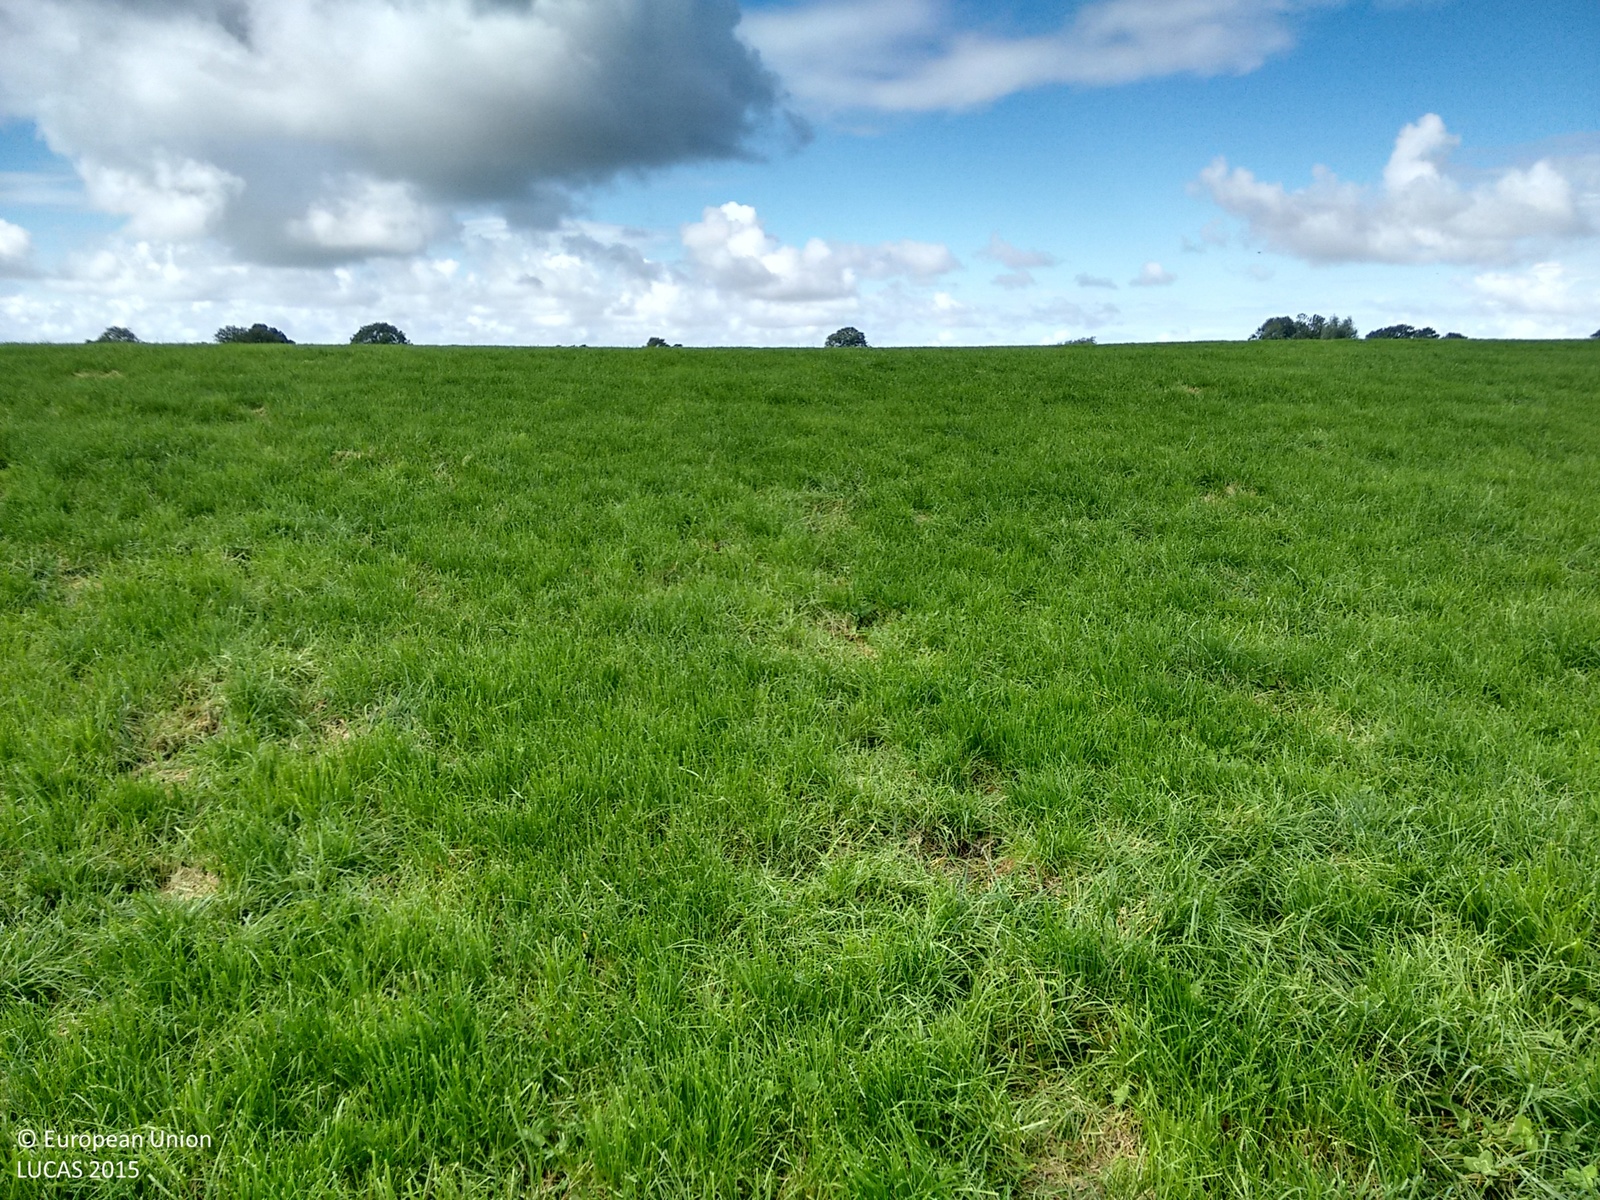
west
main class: Grassland
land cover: Grassland without tree/shrub cover
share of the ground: > 75 %
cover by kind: herbaceous plants 100 %
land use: Agriculture (excluding fallow land and kitchen gardens)
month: September
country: IE
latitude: 52.4383
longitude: -9.5189
